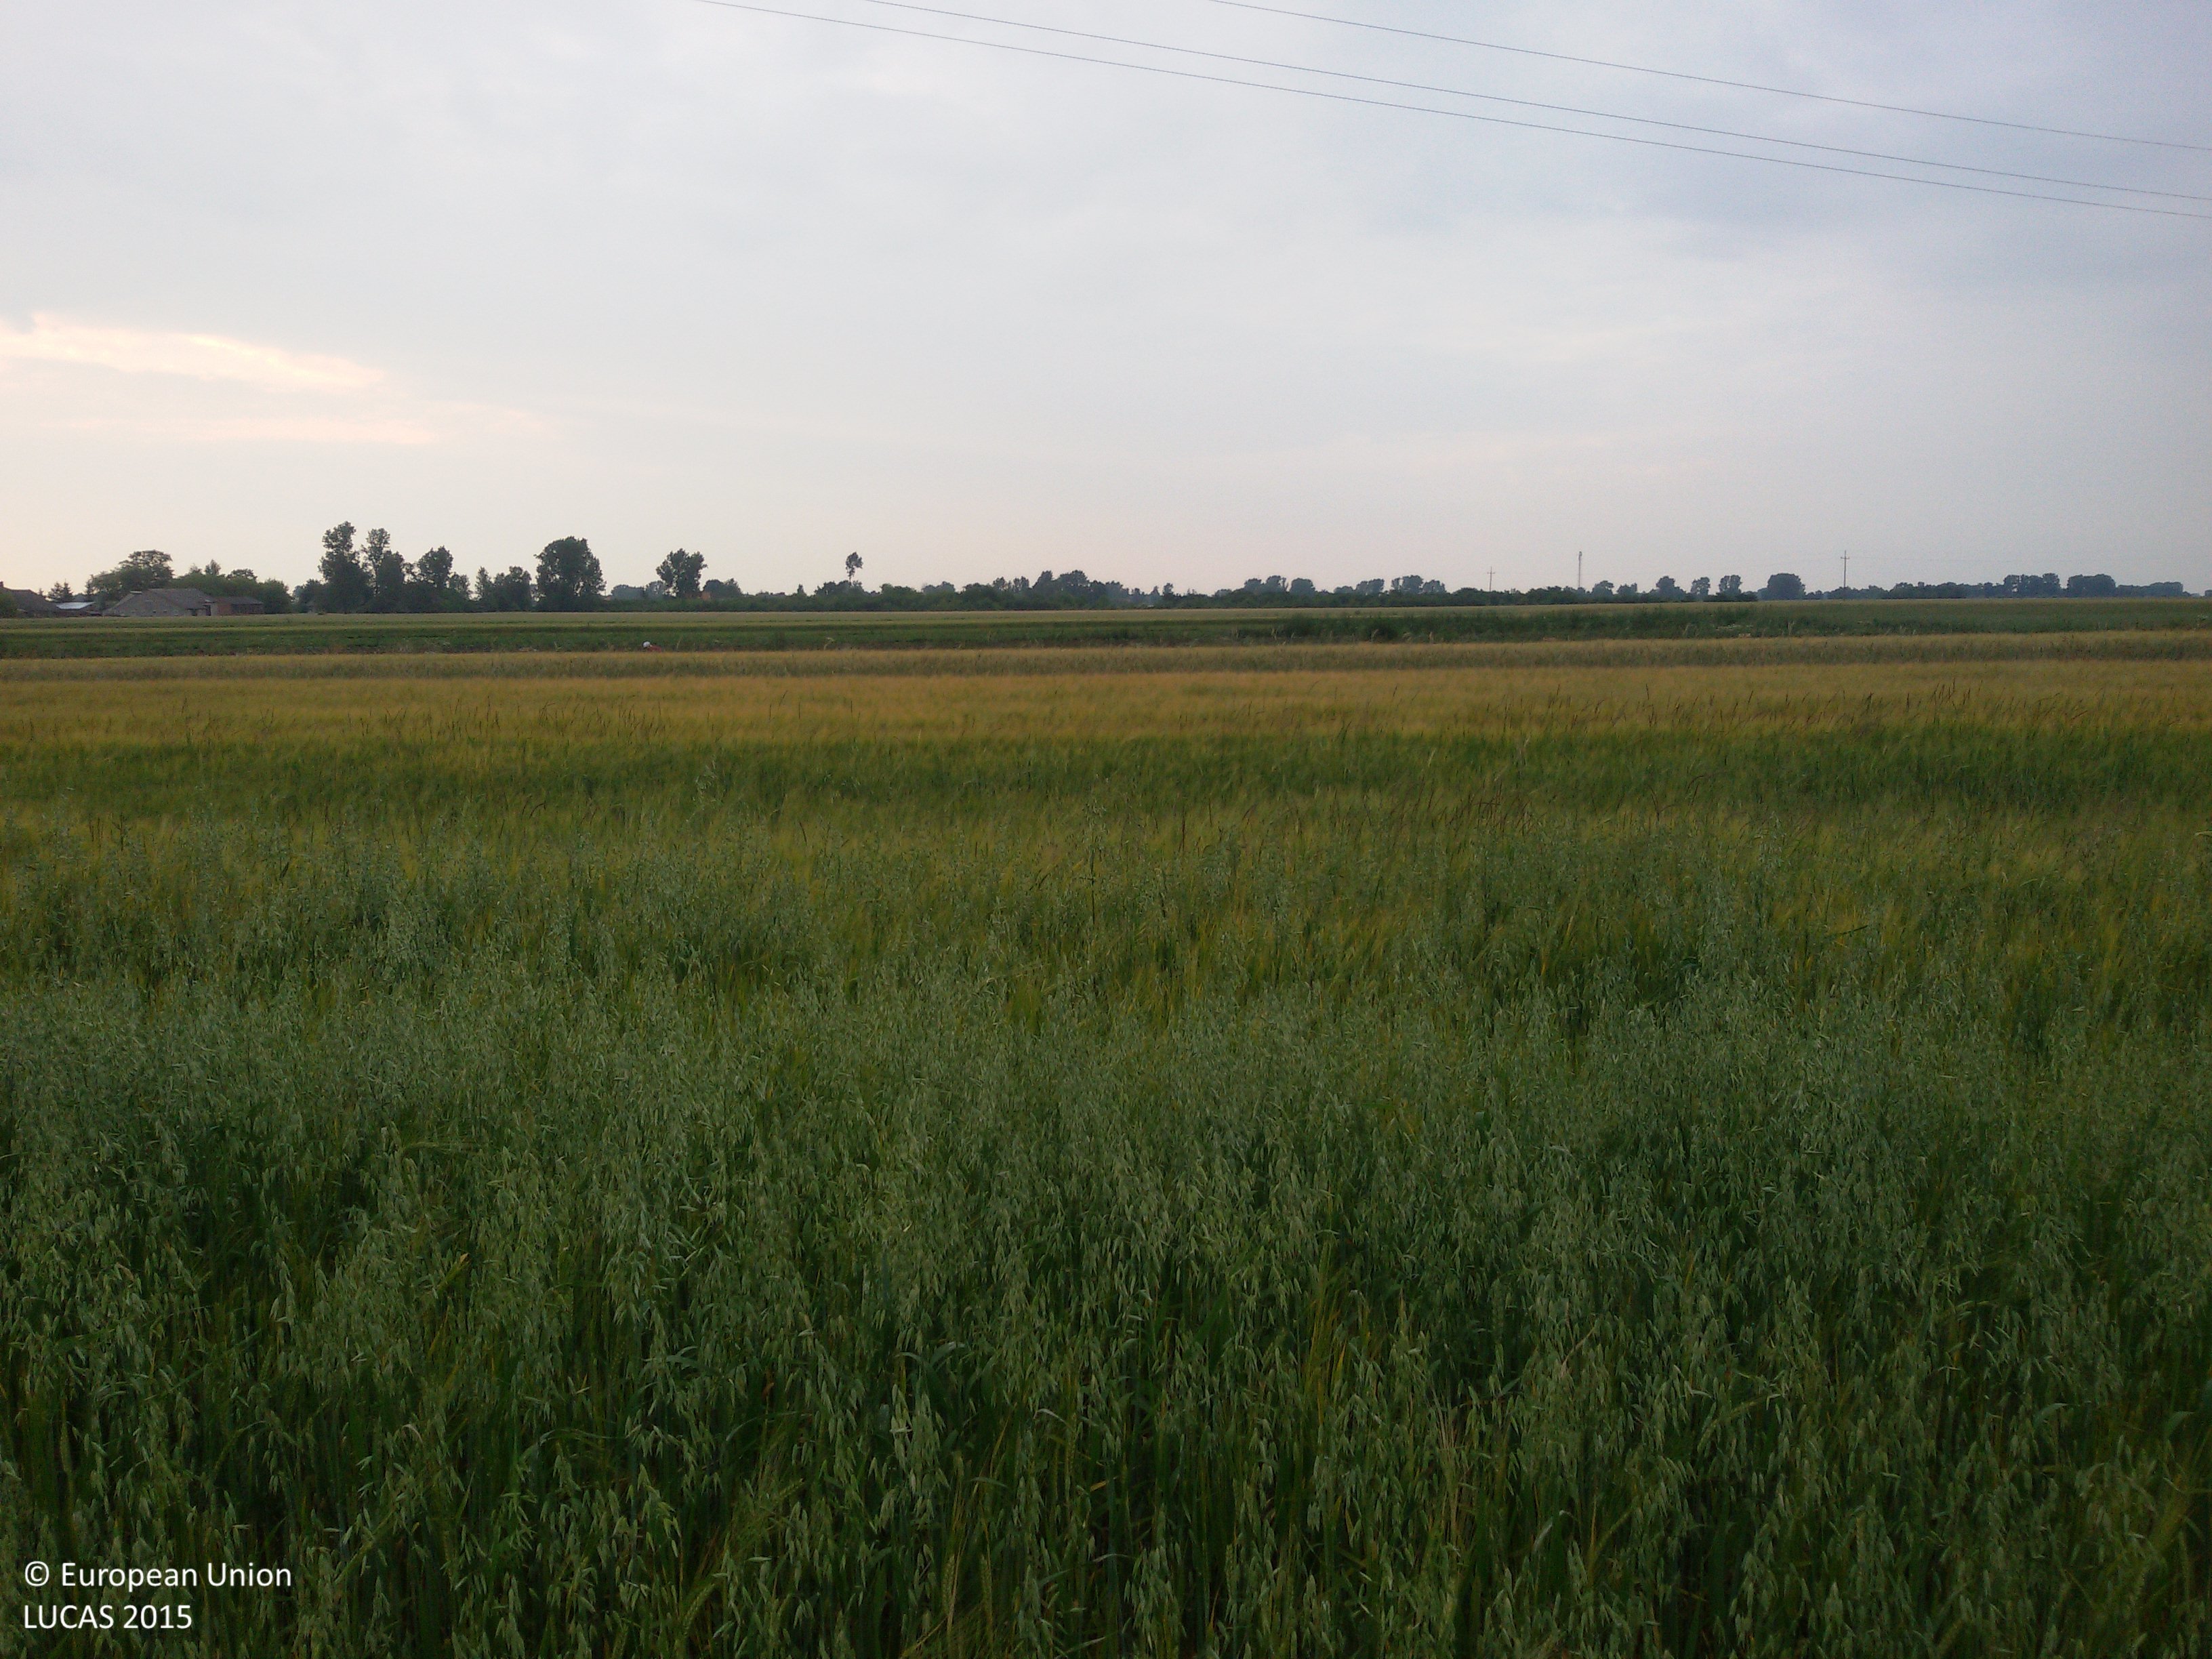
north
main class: Cropland
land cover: Oats
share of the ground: > 75 %
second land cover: Triticale
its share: > 75 %
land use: Agriculture (excluding fallow land and kitchen gardens)
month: June
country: PL
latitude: 52.1773
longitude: 19.9323
